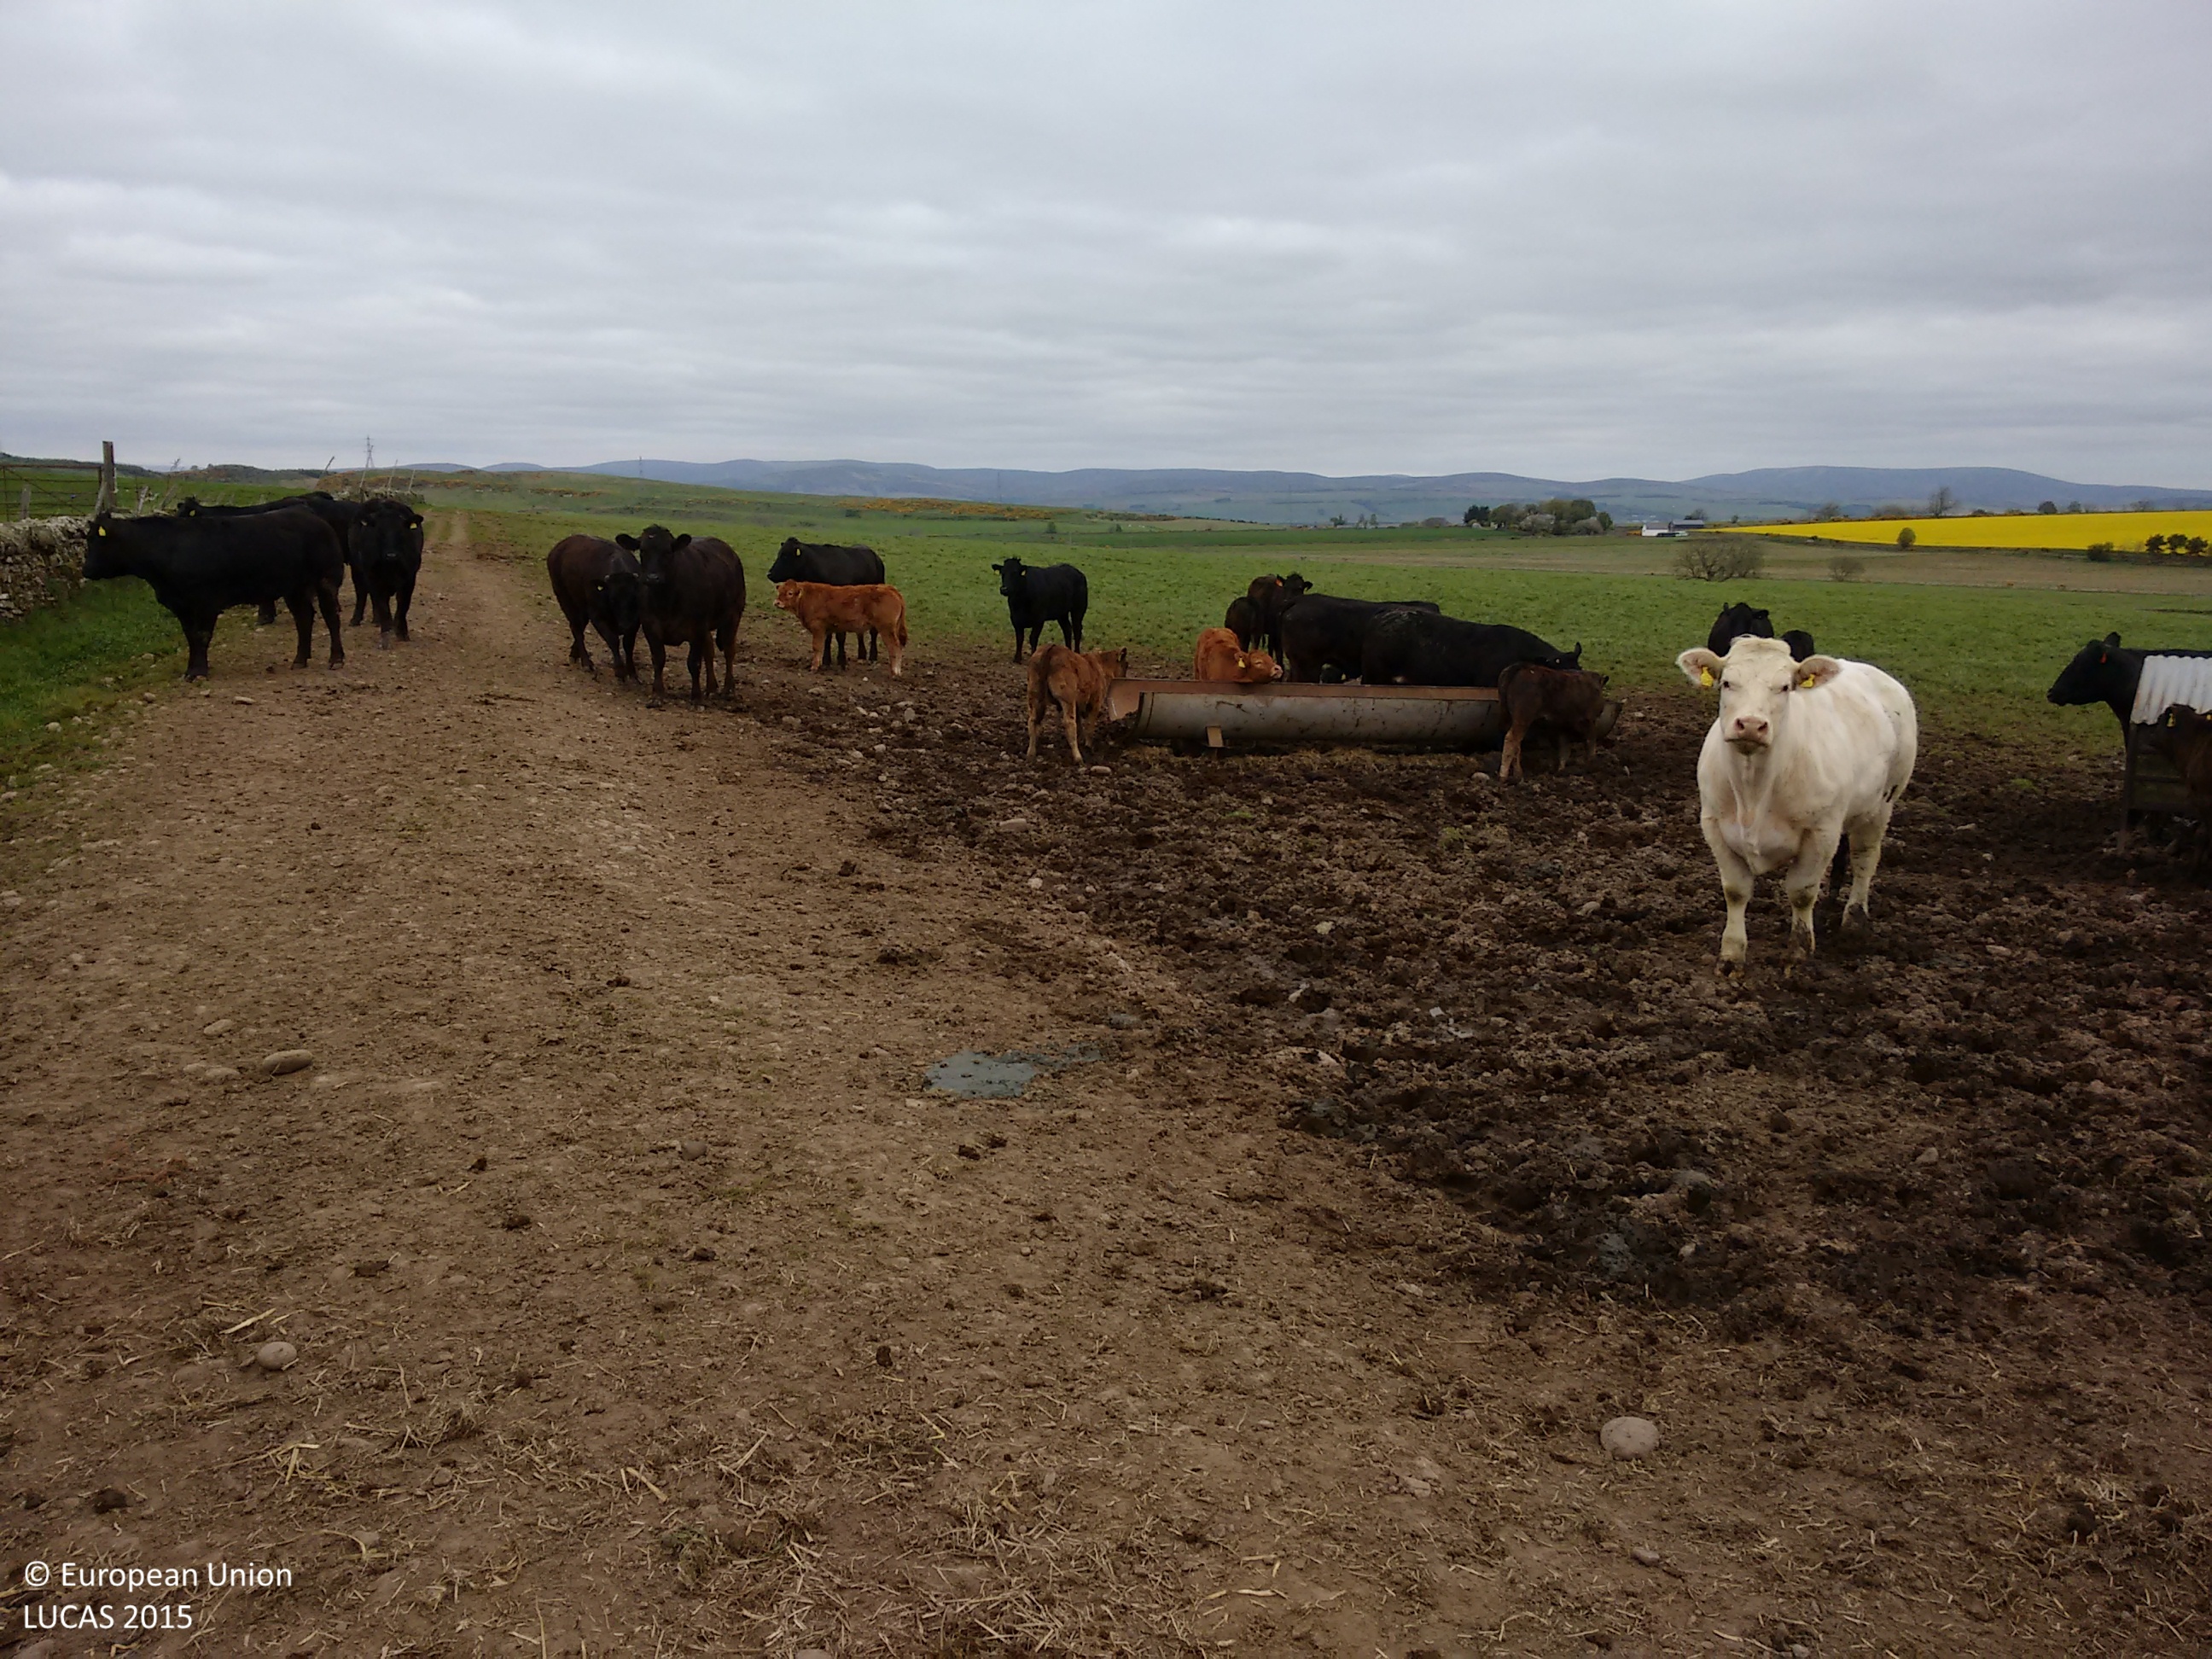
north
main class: Grassland
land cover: Grassland without tree/shrub cover
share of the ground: 50 - 75 %
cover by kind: herbaceous plants 75 %, unconsolidated bare surface 25 %
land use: Agriculture (excluding fallow land and kitchen gardens)
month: May
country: GB
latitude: 56.6763
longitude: -2.7753
